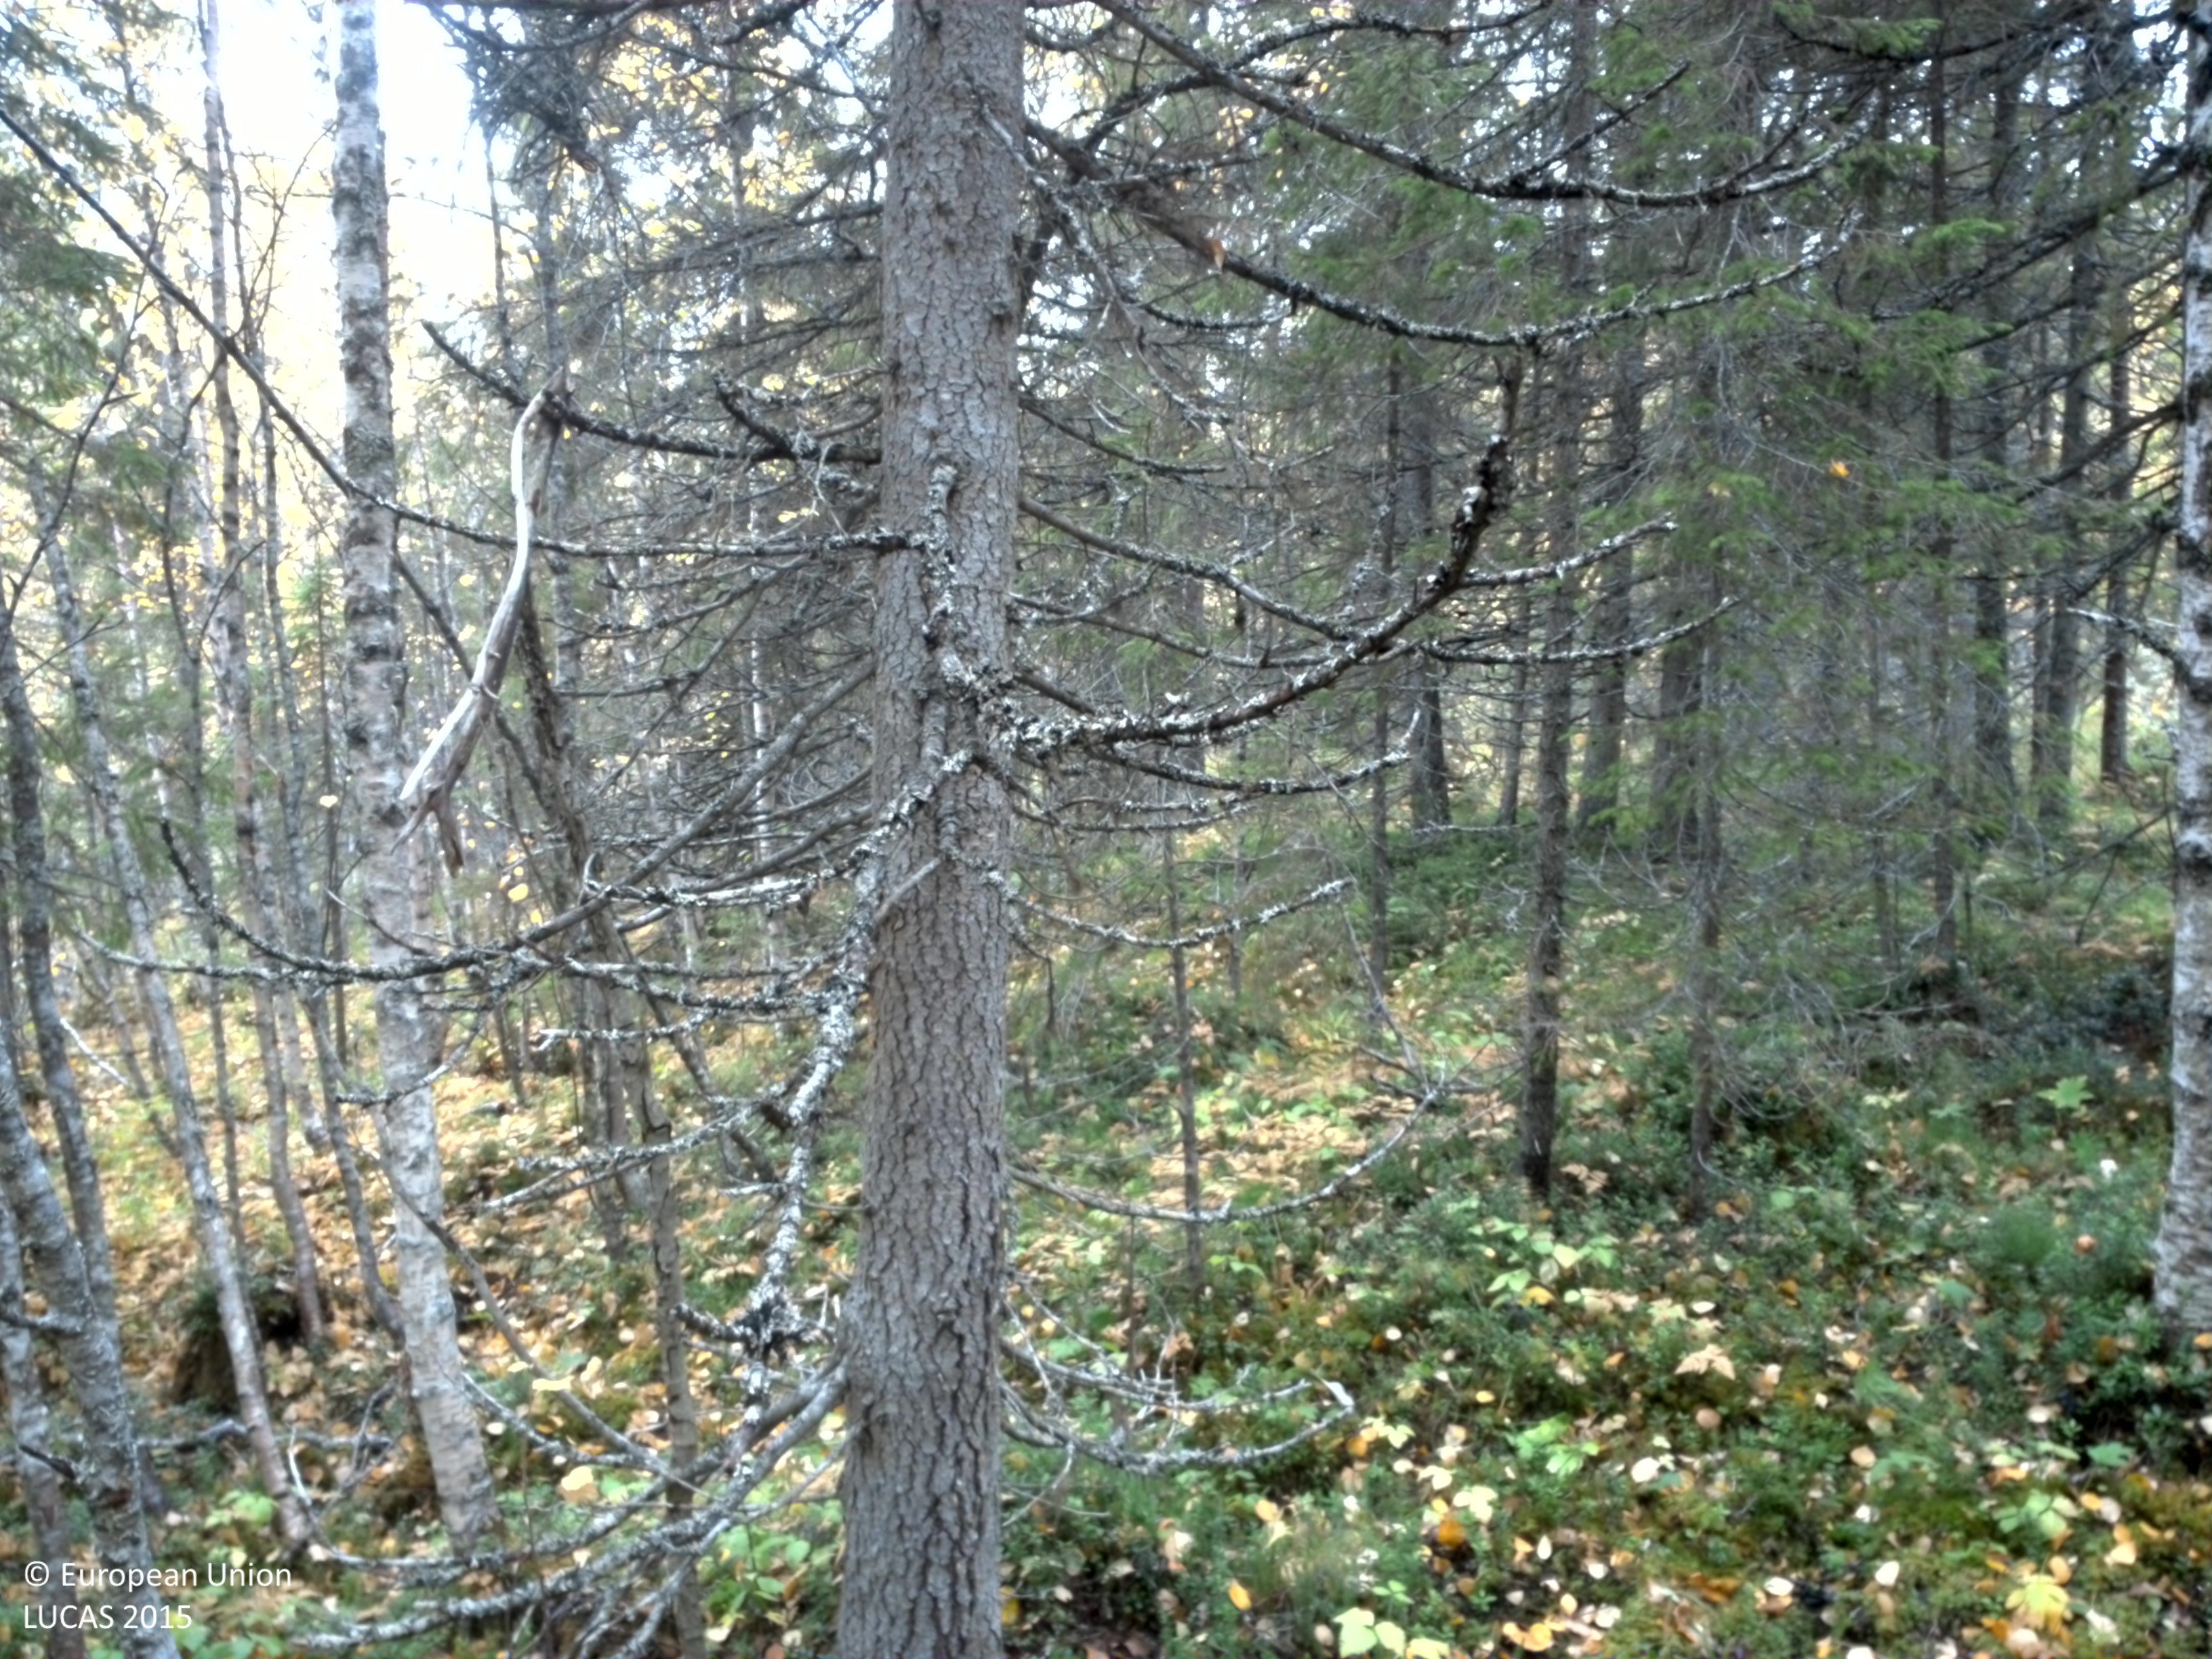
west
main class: Woodland
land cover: Spruce dominated mixed woodland
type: boreal forest
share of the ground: 50 - 75 %
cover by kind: coniferous forest trees 35 %, broadleaved forest trees 25 %, herbaceous plants 20 %, shrubs 10 %, lichens and mosses 10 %
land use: Forestry
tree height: > 5 m
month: September
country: SE
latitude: 65.3639
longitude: 16.2194
